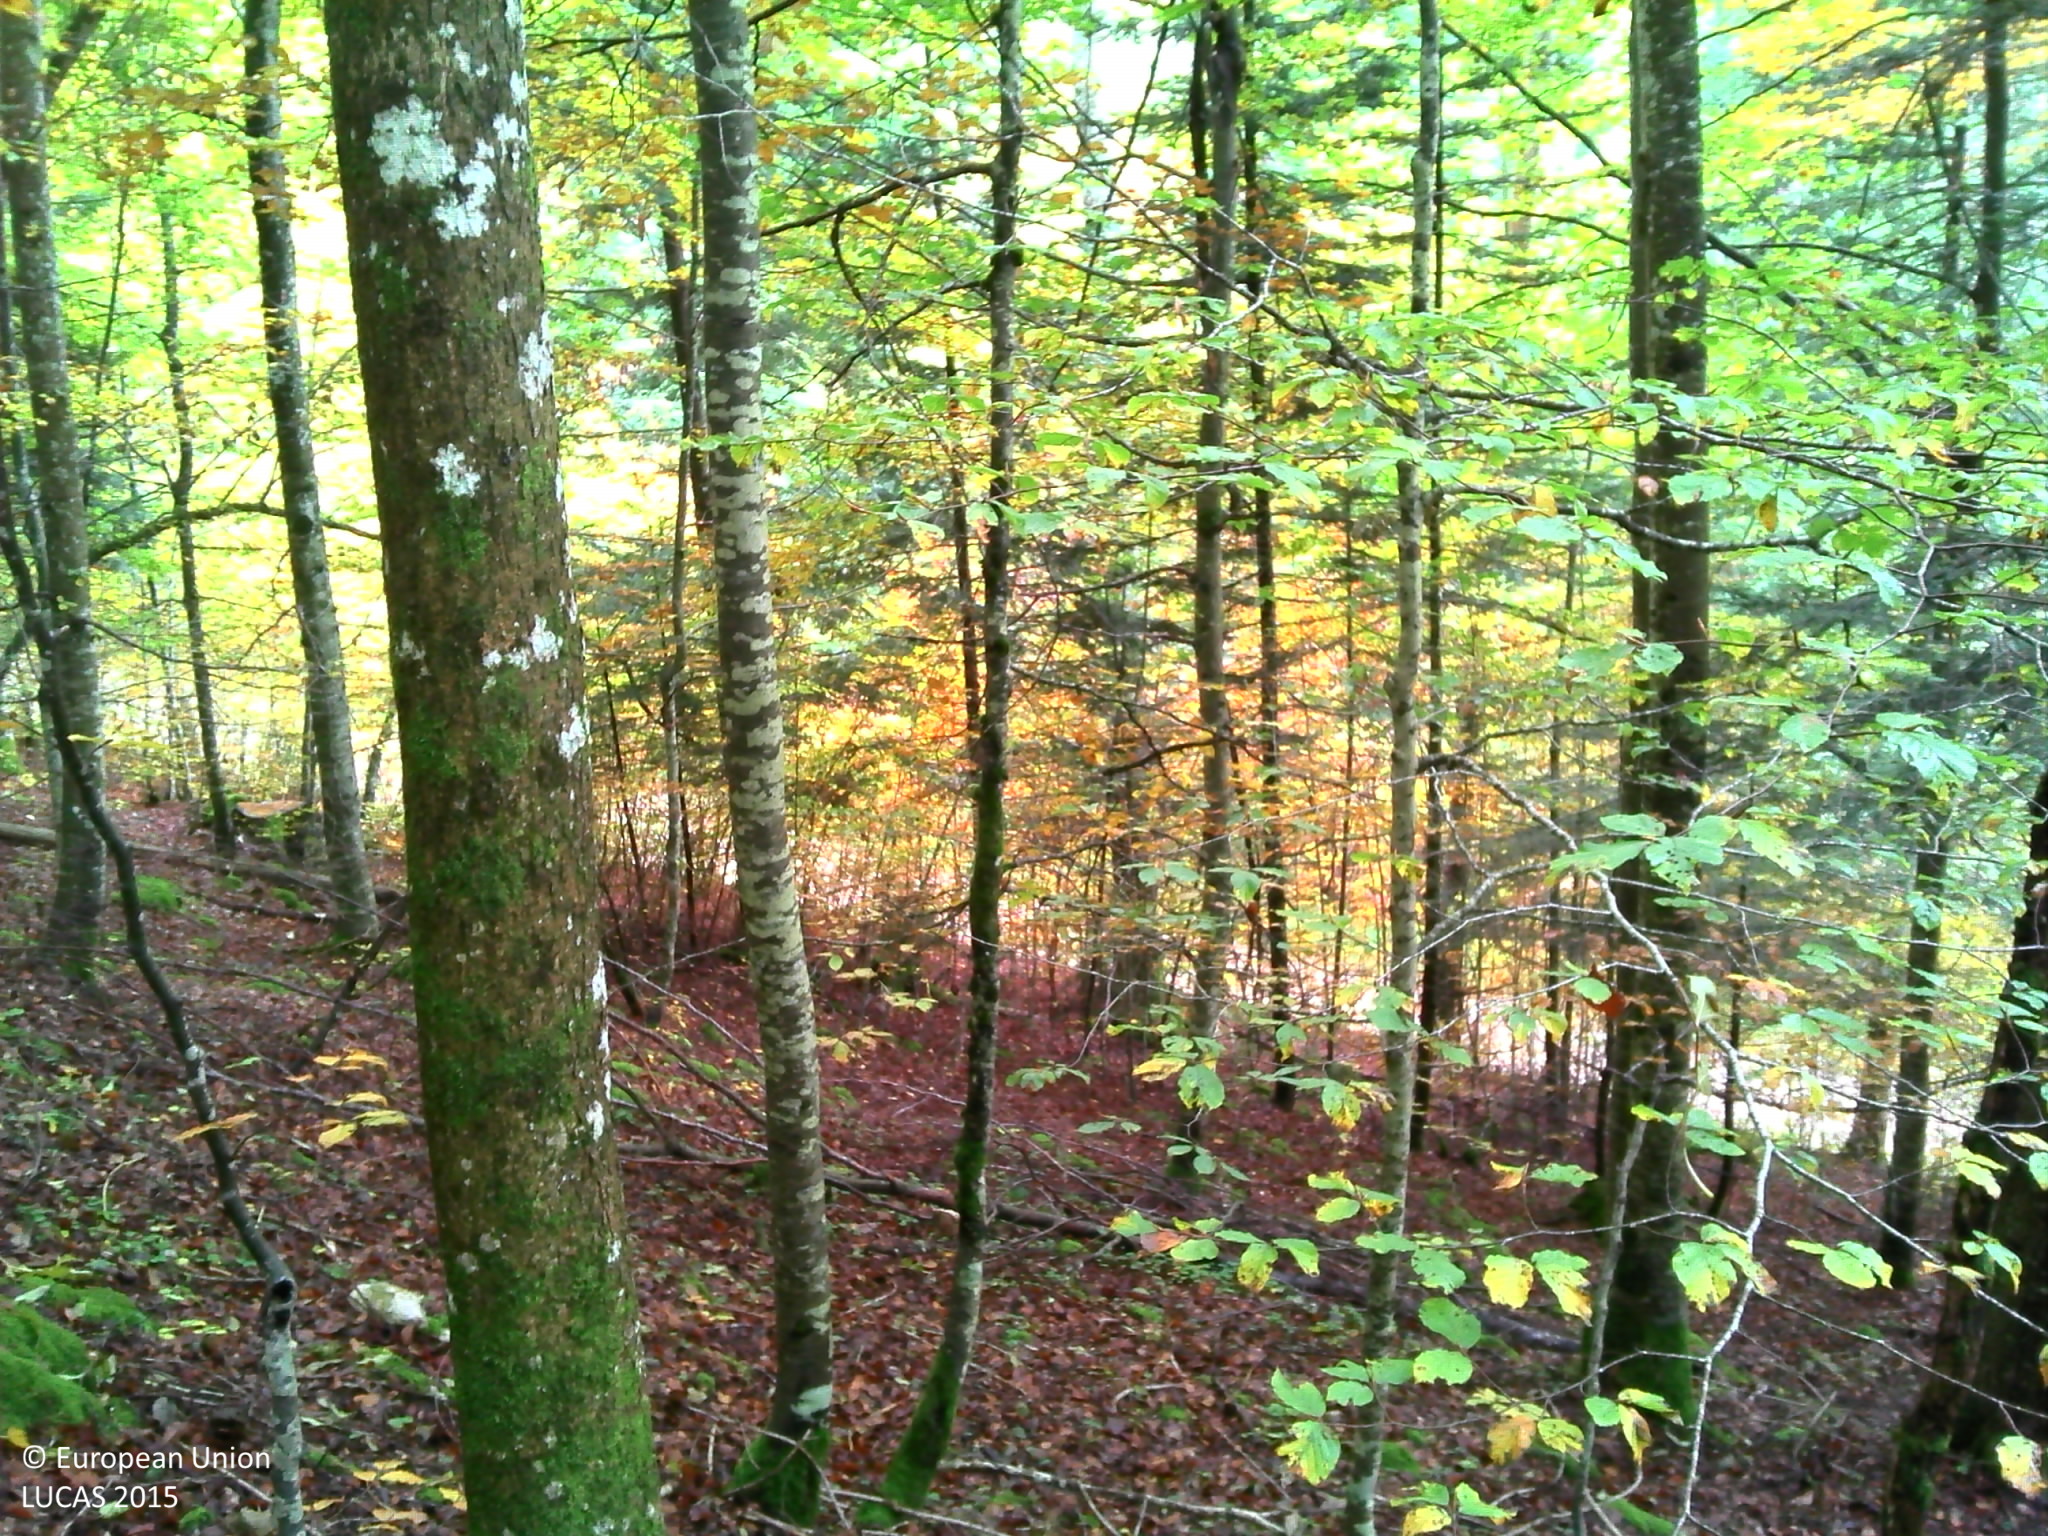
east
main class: Woodland
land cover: Spruce dominated mixed woodland
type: mountainous beech forest
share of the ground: 50 - 75 %
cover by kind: broadleaved forest trees 40 %, coniferous forest trees 30 %, unconsolidated bare surface 20 %, lichens and mosses 5 %, consolidated bare surface 5 %
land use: Forestry
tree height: > 5 m
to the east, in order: Spruce dominated mixed woodland; Paved roads, cycling and walking lanes; Spruce dominated mixed woodland; Paved roads, cycling and walking lanes; Broadleaved woodland; Spontaneously vegetated surfaces; Spruce dominated mixed woodland; Fences; Spruce dominated coniferous woodland; Spruce dominated mixed woodland; Grassland without tree/shrub cover
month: October
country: FR
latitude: 46.7594
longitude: 6.4022
